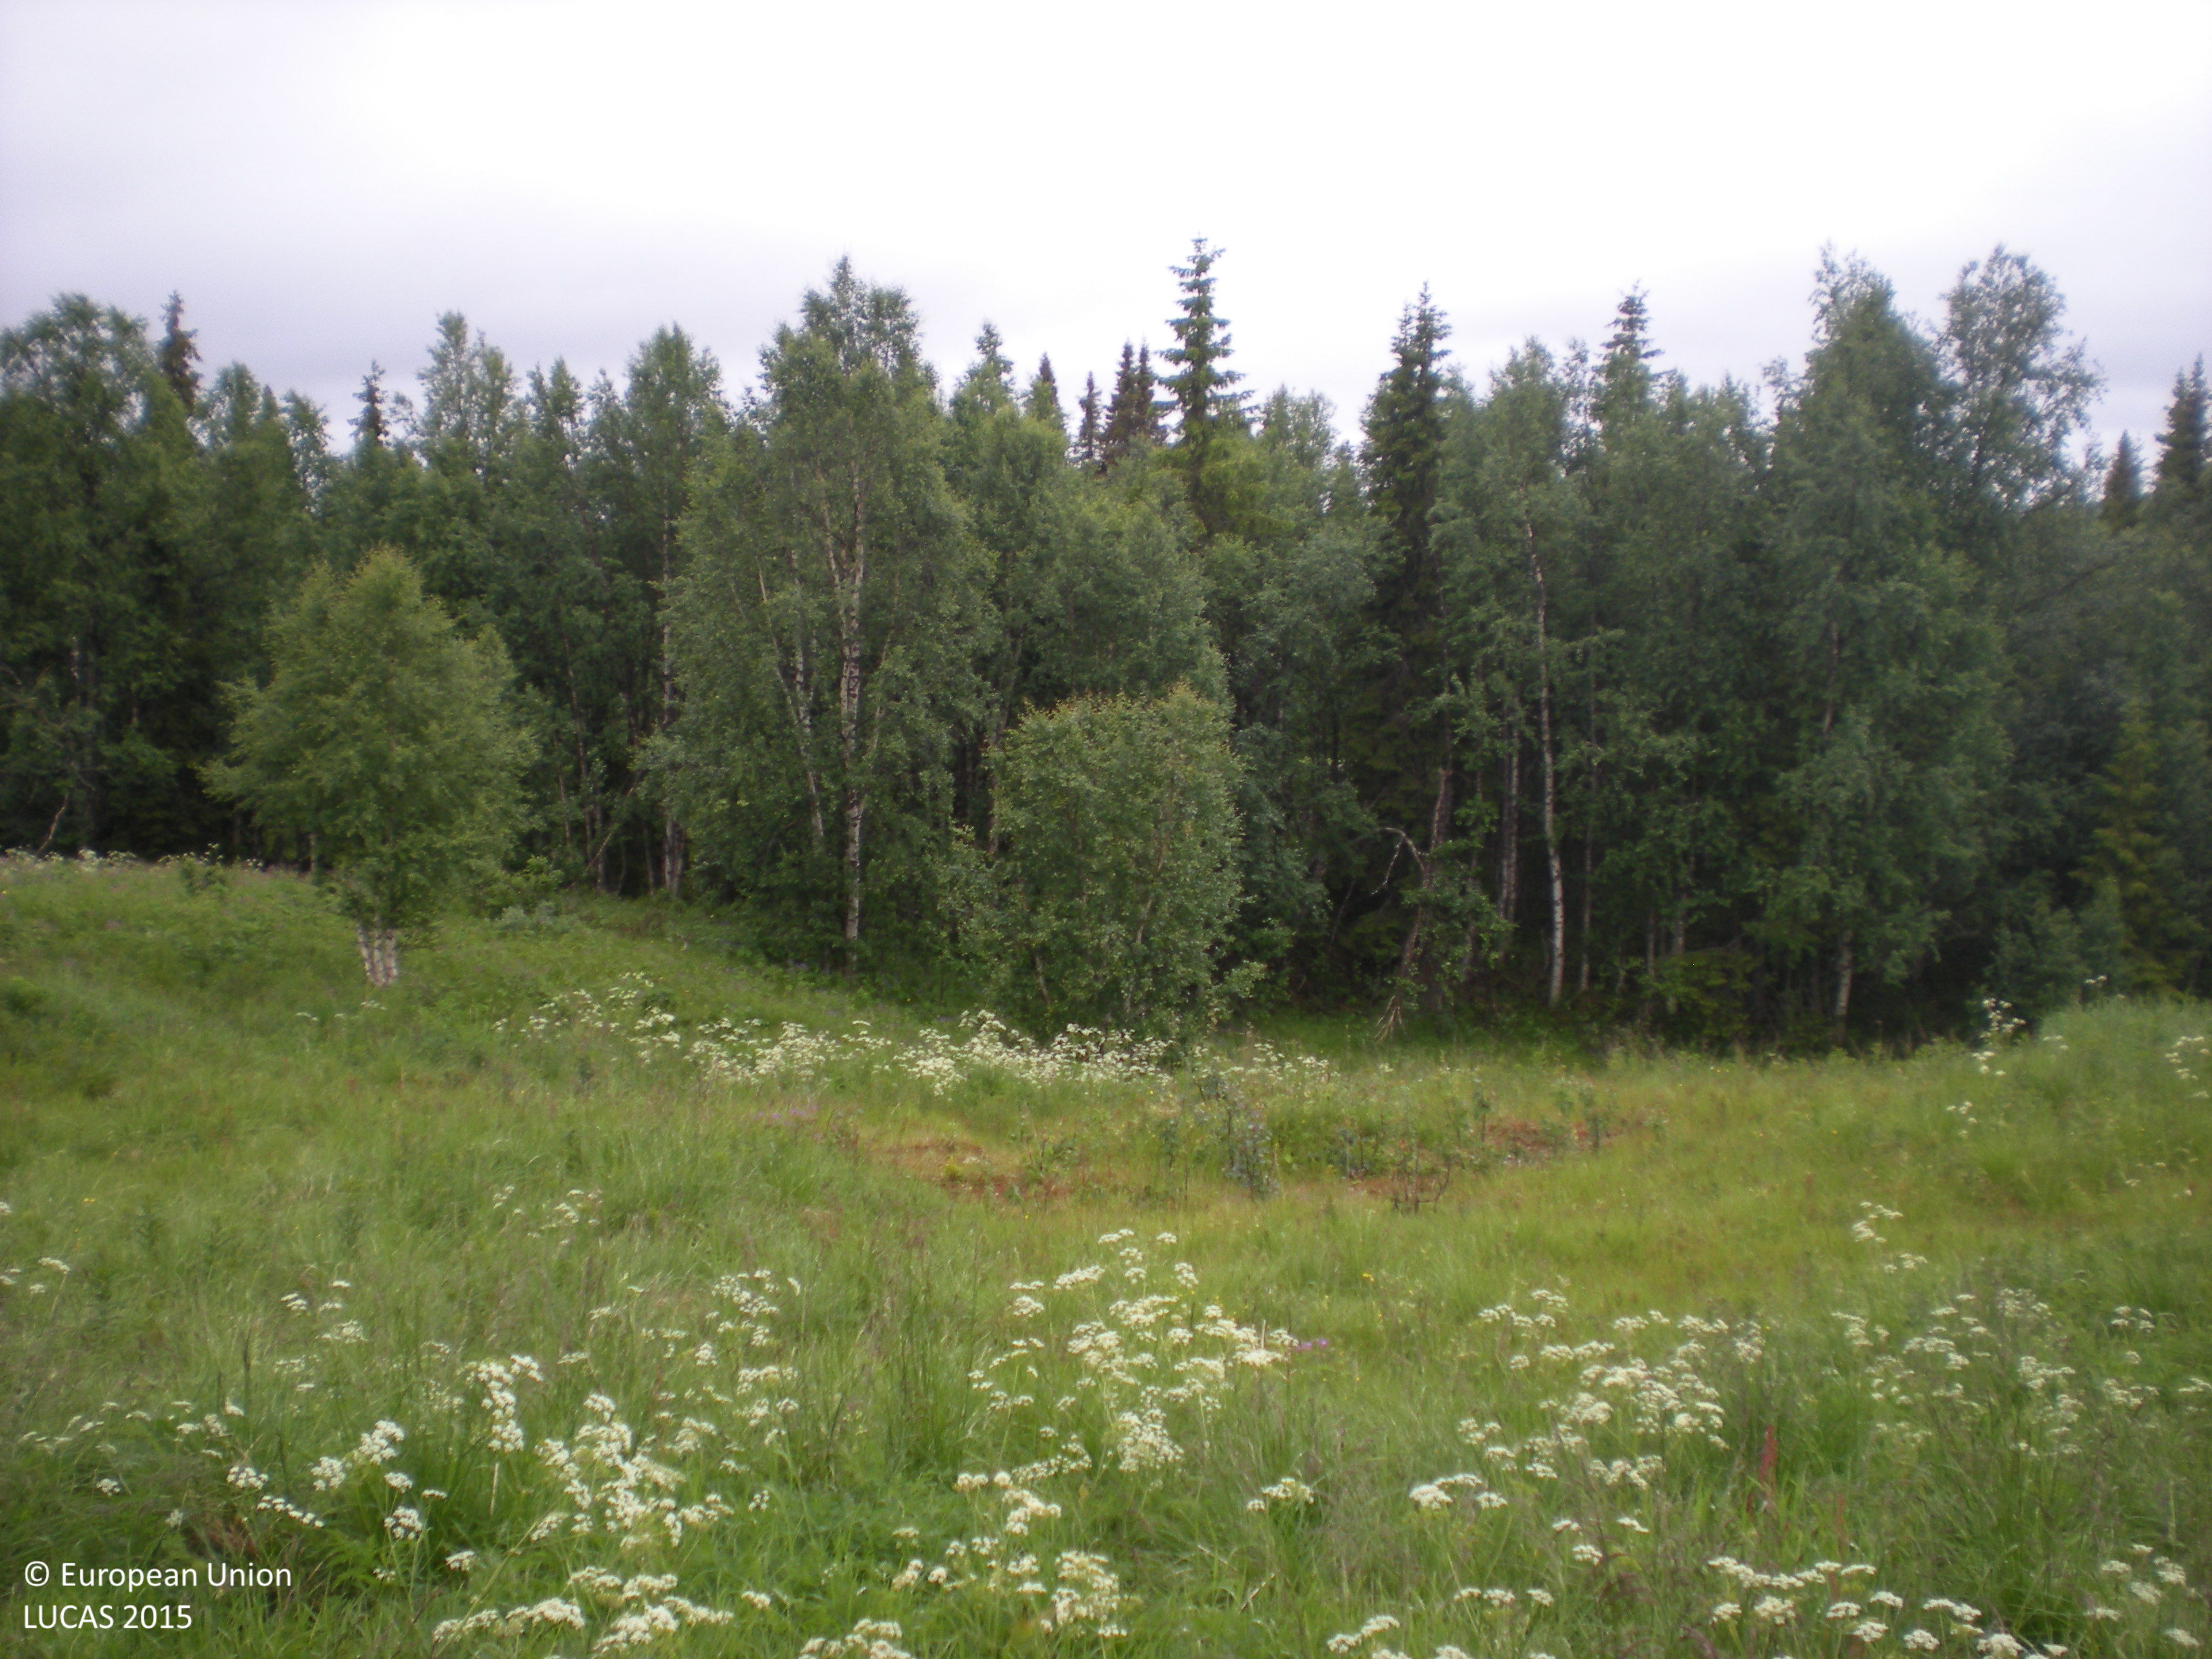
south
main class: Grassland
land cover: Grassland with sparse tree/shrub cover
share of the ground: > 75 %
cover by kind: herbaceous plants 95 %, broadleaved forest trees 5 %
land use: Agriculture (excluding fallow land and kitchen gardens)
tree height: < 5 m
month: July
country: SE
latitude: 65.8143
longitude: 17.1982
